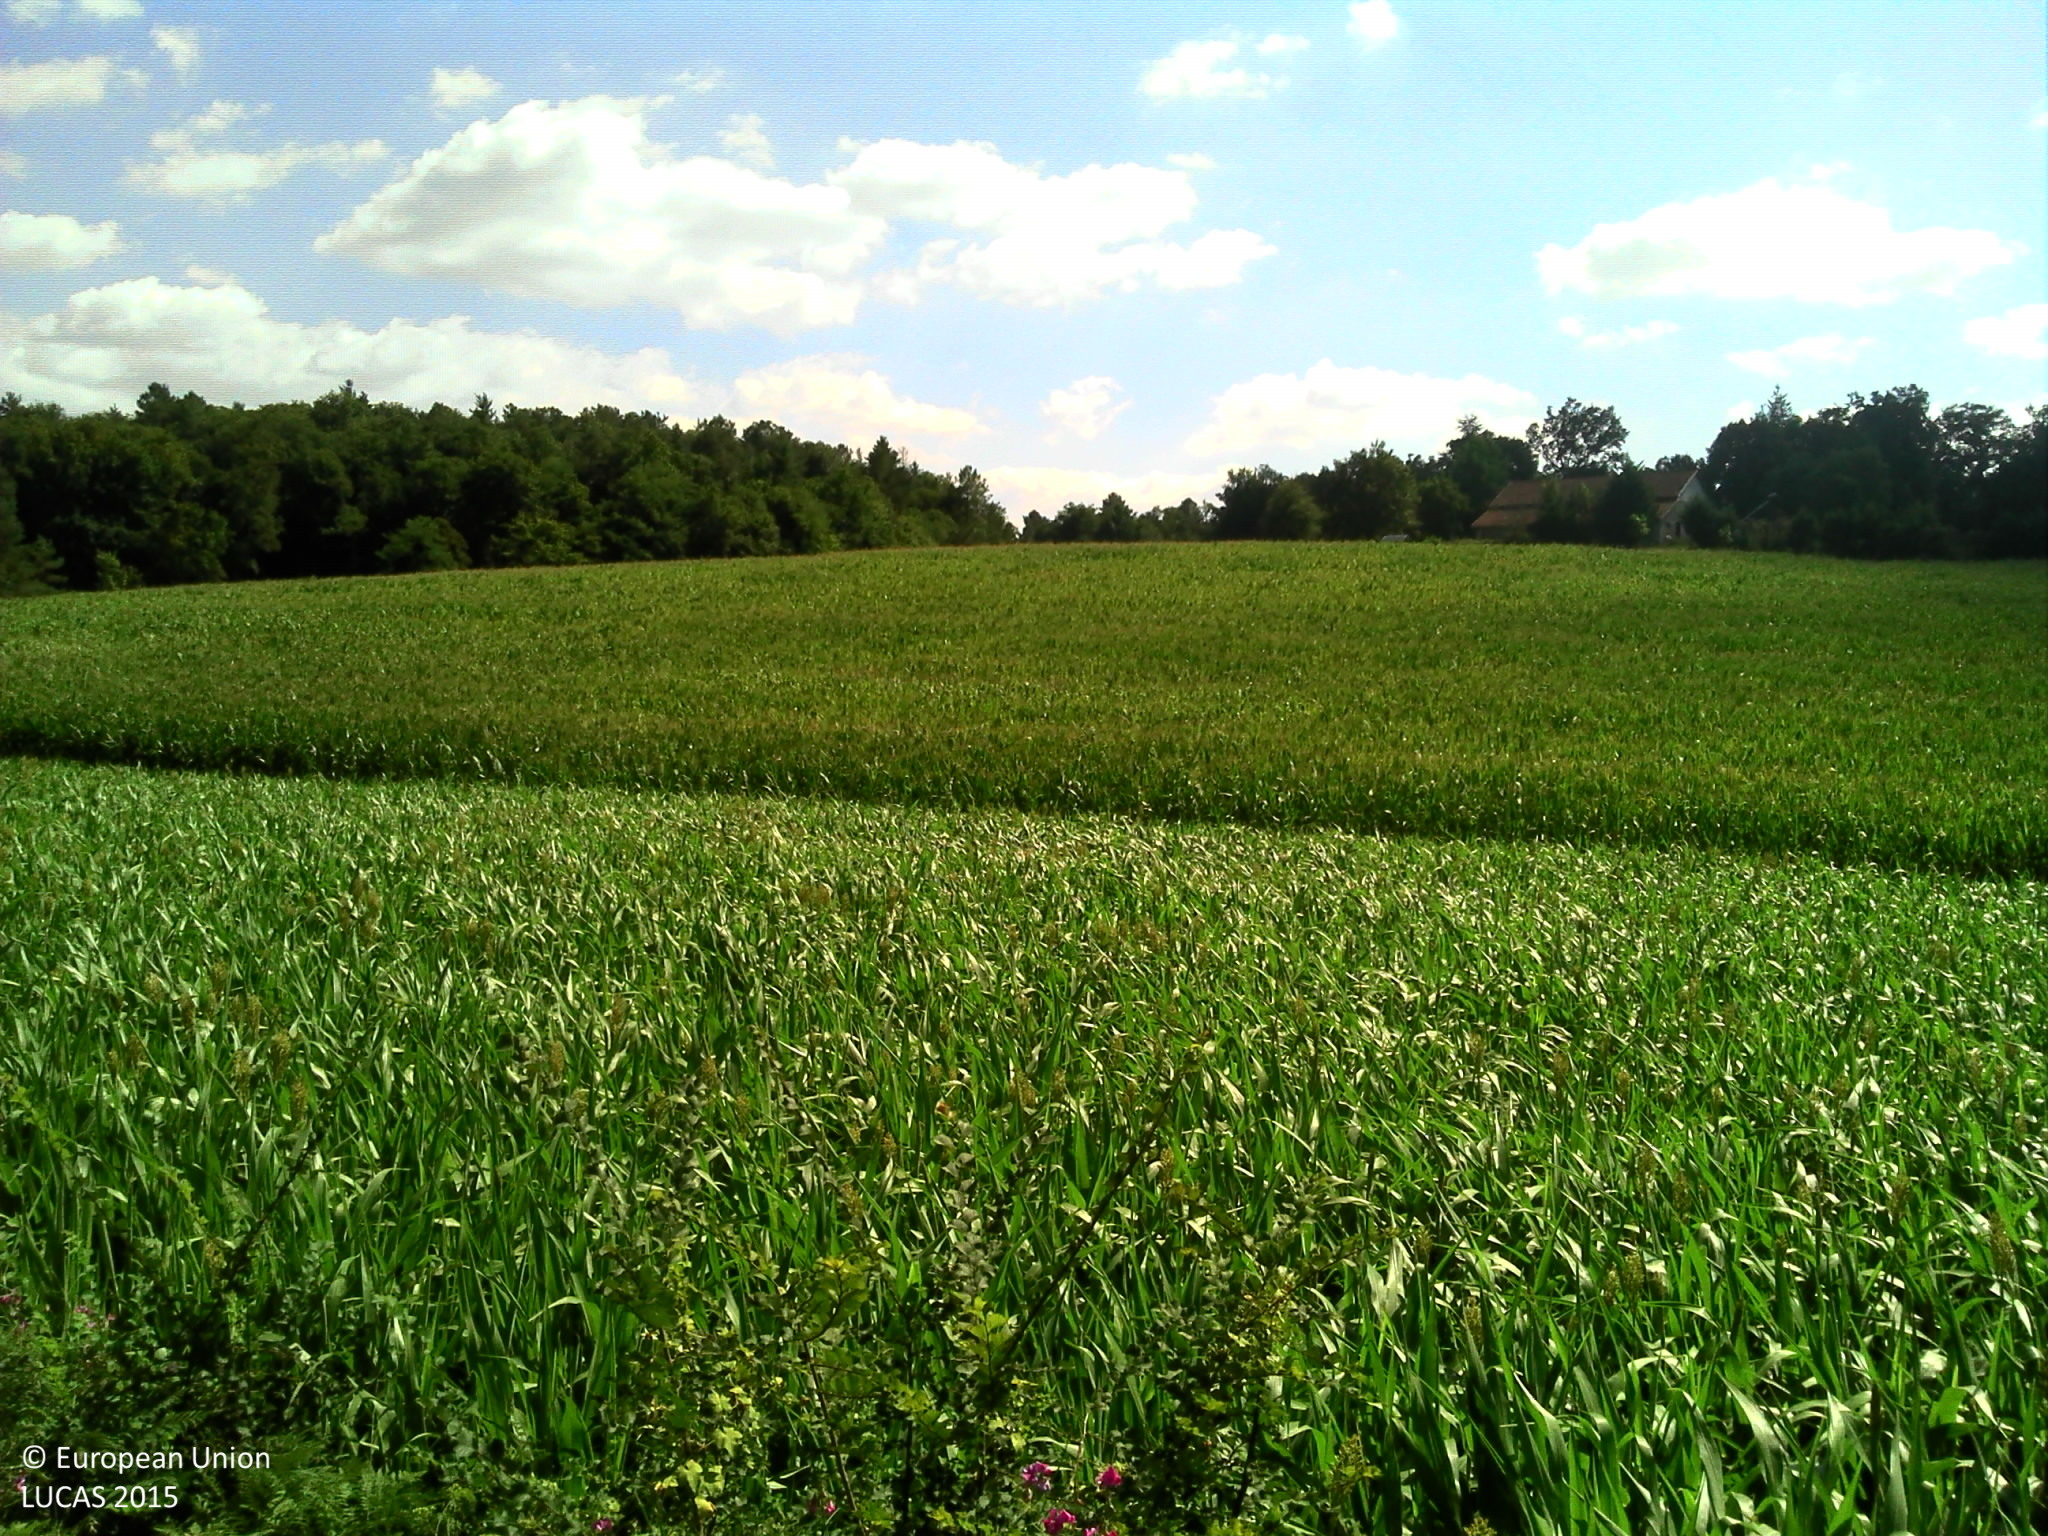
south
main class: Cropland
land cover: Maize
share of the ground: > 75 %
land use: Agriculture (excluding fallow land and kitchen gardens)
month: August
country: FR
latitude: 45.2787
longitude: 0.7477
